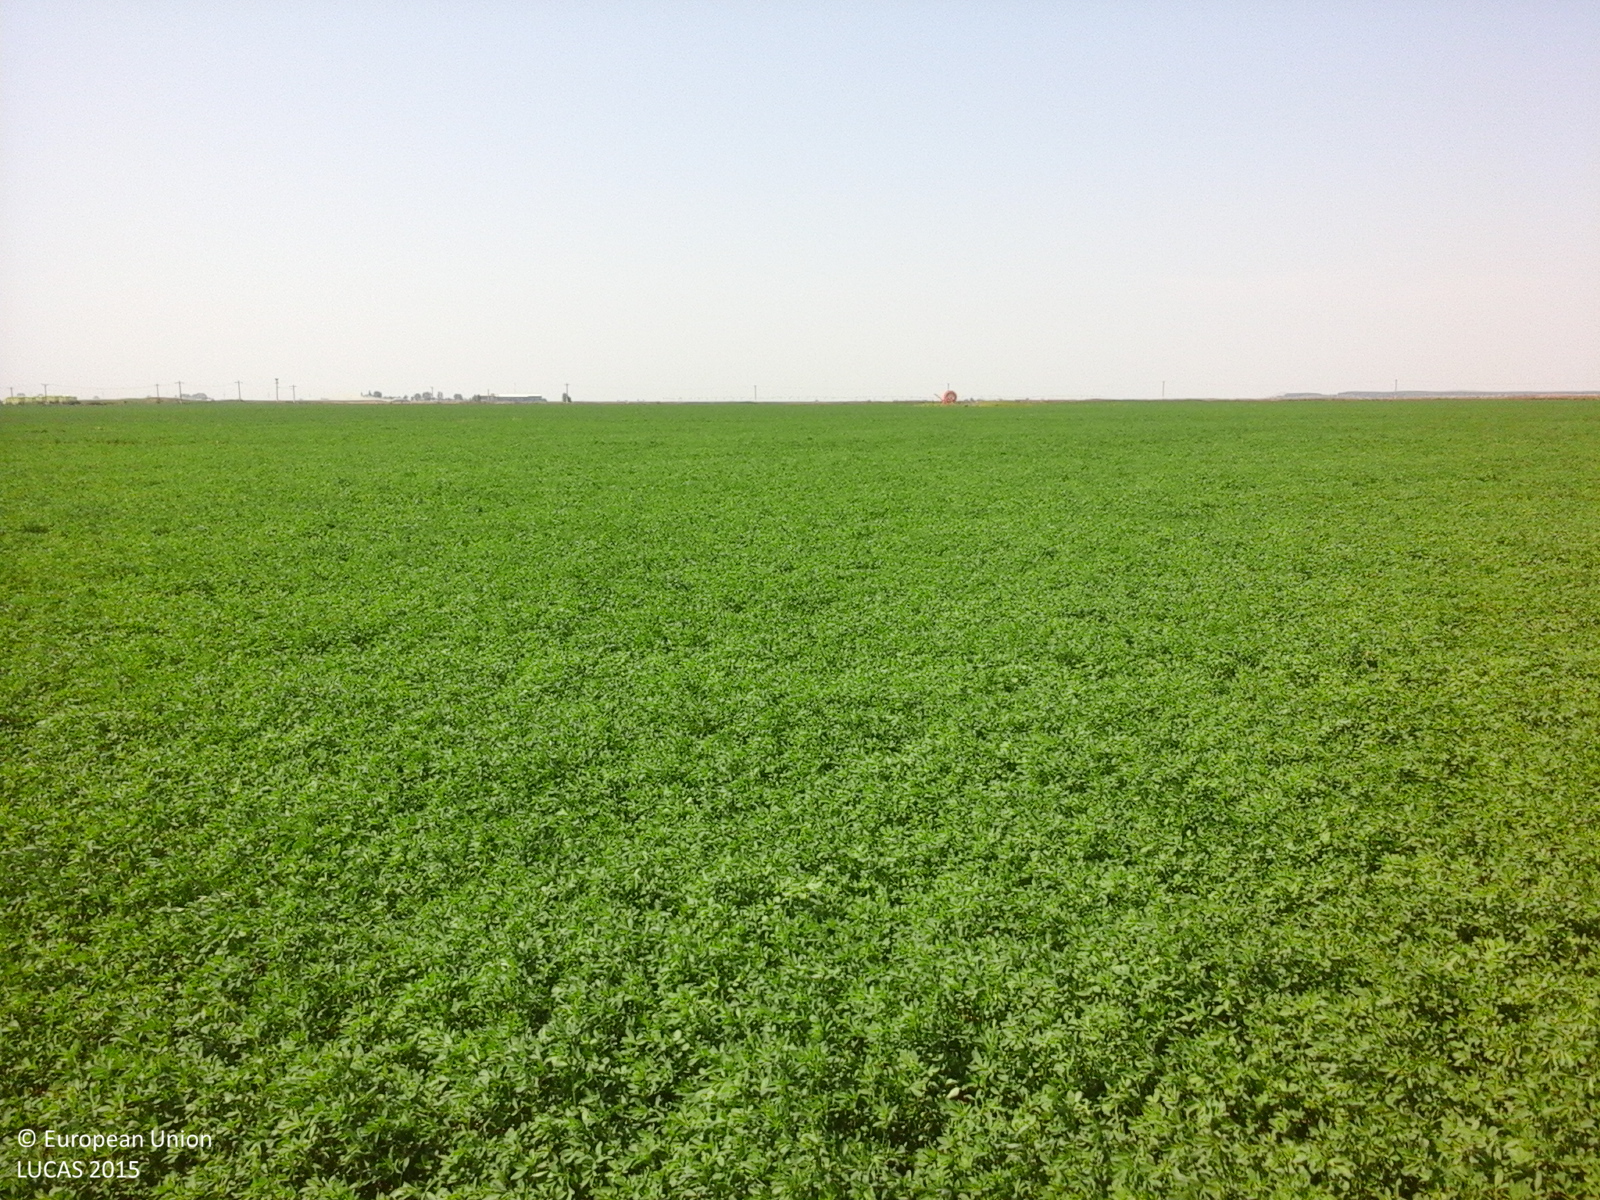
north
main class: Cropland
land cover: Lucerne
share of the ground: > 75 %
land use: Agriculture (excluding fallow land and kitchen gardens)
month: August
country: RO
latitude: 45.1255
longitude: 28.0810
